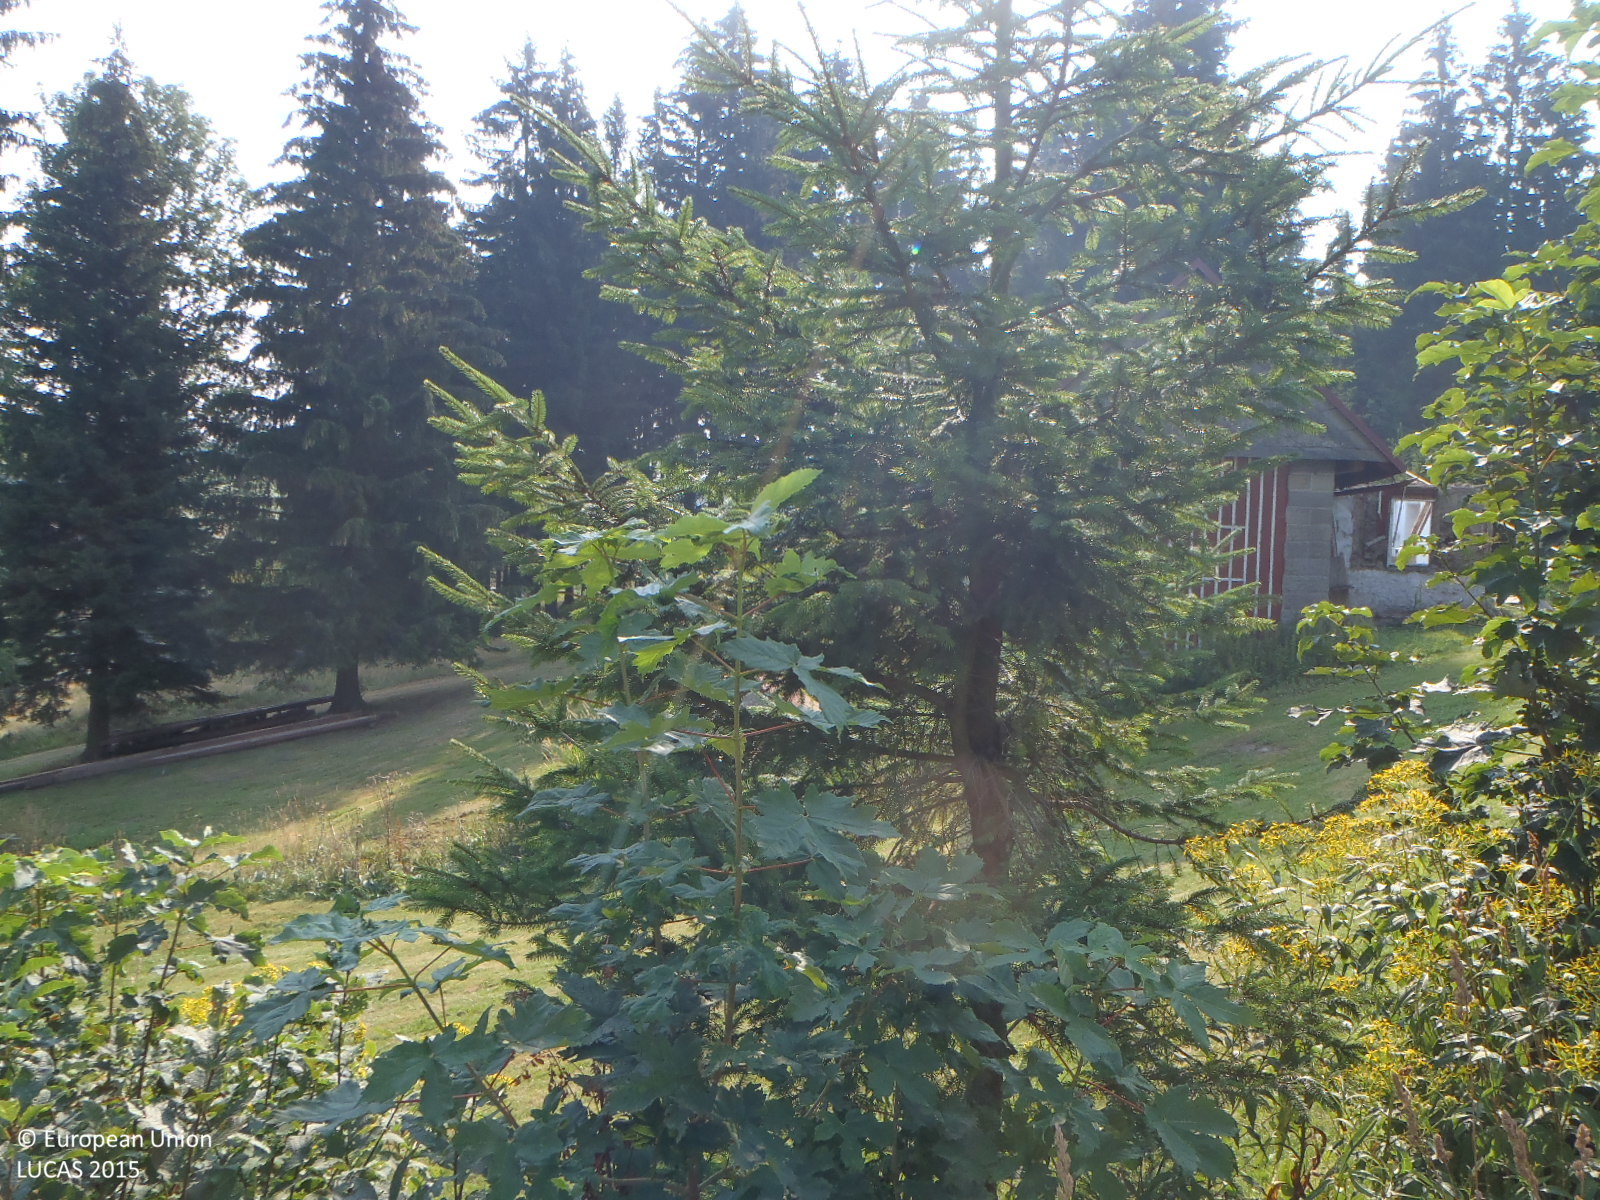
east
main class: Grassland
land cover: Grassland without tree/shrub cover
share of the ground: > 75 %
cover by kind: herbaceous plants 100 %
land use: Agriculture (excluding fallow land and kitchen gardens)
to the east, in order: Grassland without tree/shrub cover; Abandoned hedges; Artificial constructions in urban areas; Grassland without tree/shrub cover; Spruce dominated coniferous woodland; Broadleaved woodland; Grassland with sparse tree/shrub cover; Spruce dominated mixed woodland; Fences; Grassland without tree/shrub cover; Spruce dominated mixed woodland; Ditches and canals; Grassland without tree/shrub cover
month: August
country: CZ
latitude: 50.7488
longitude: 15.2334
